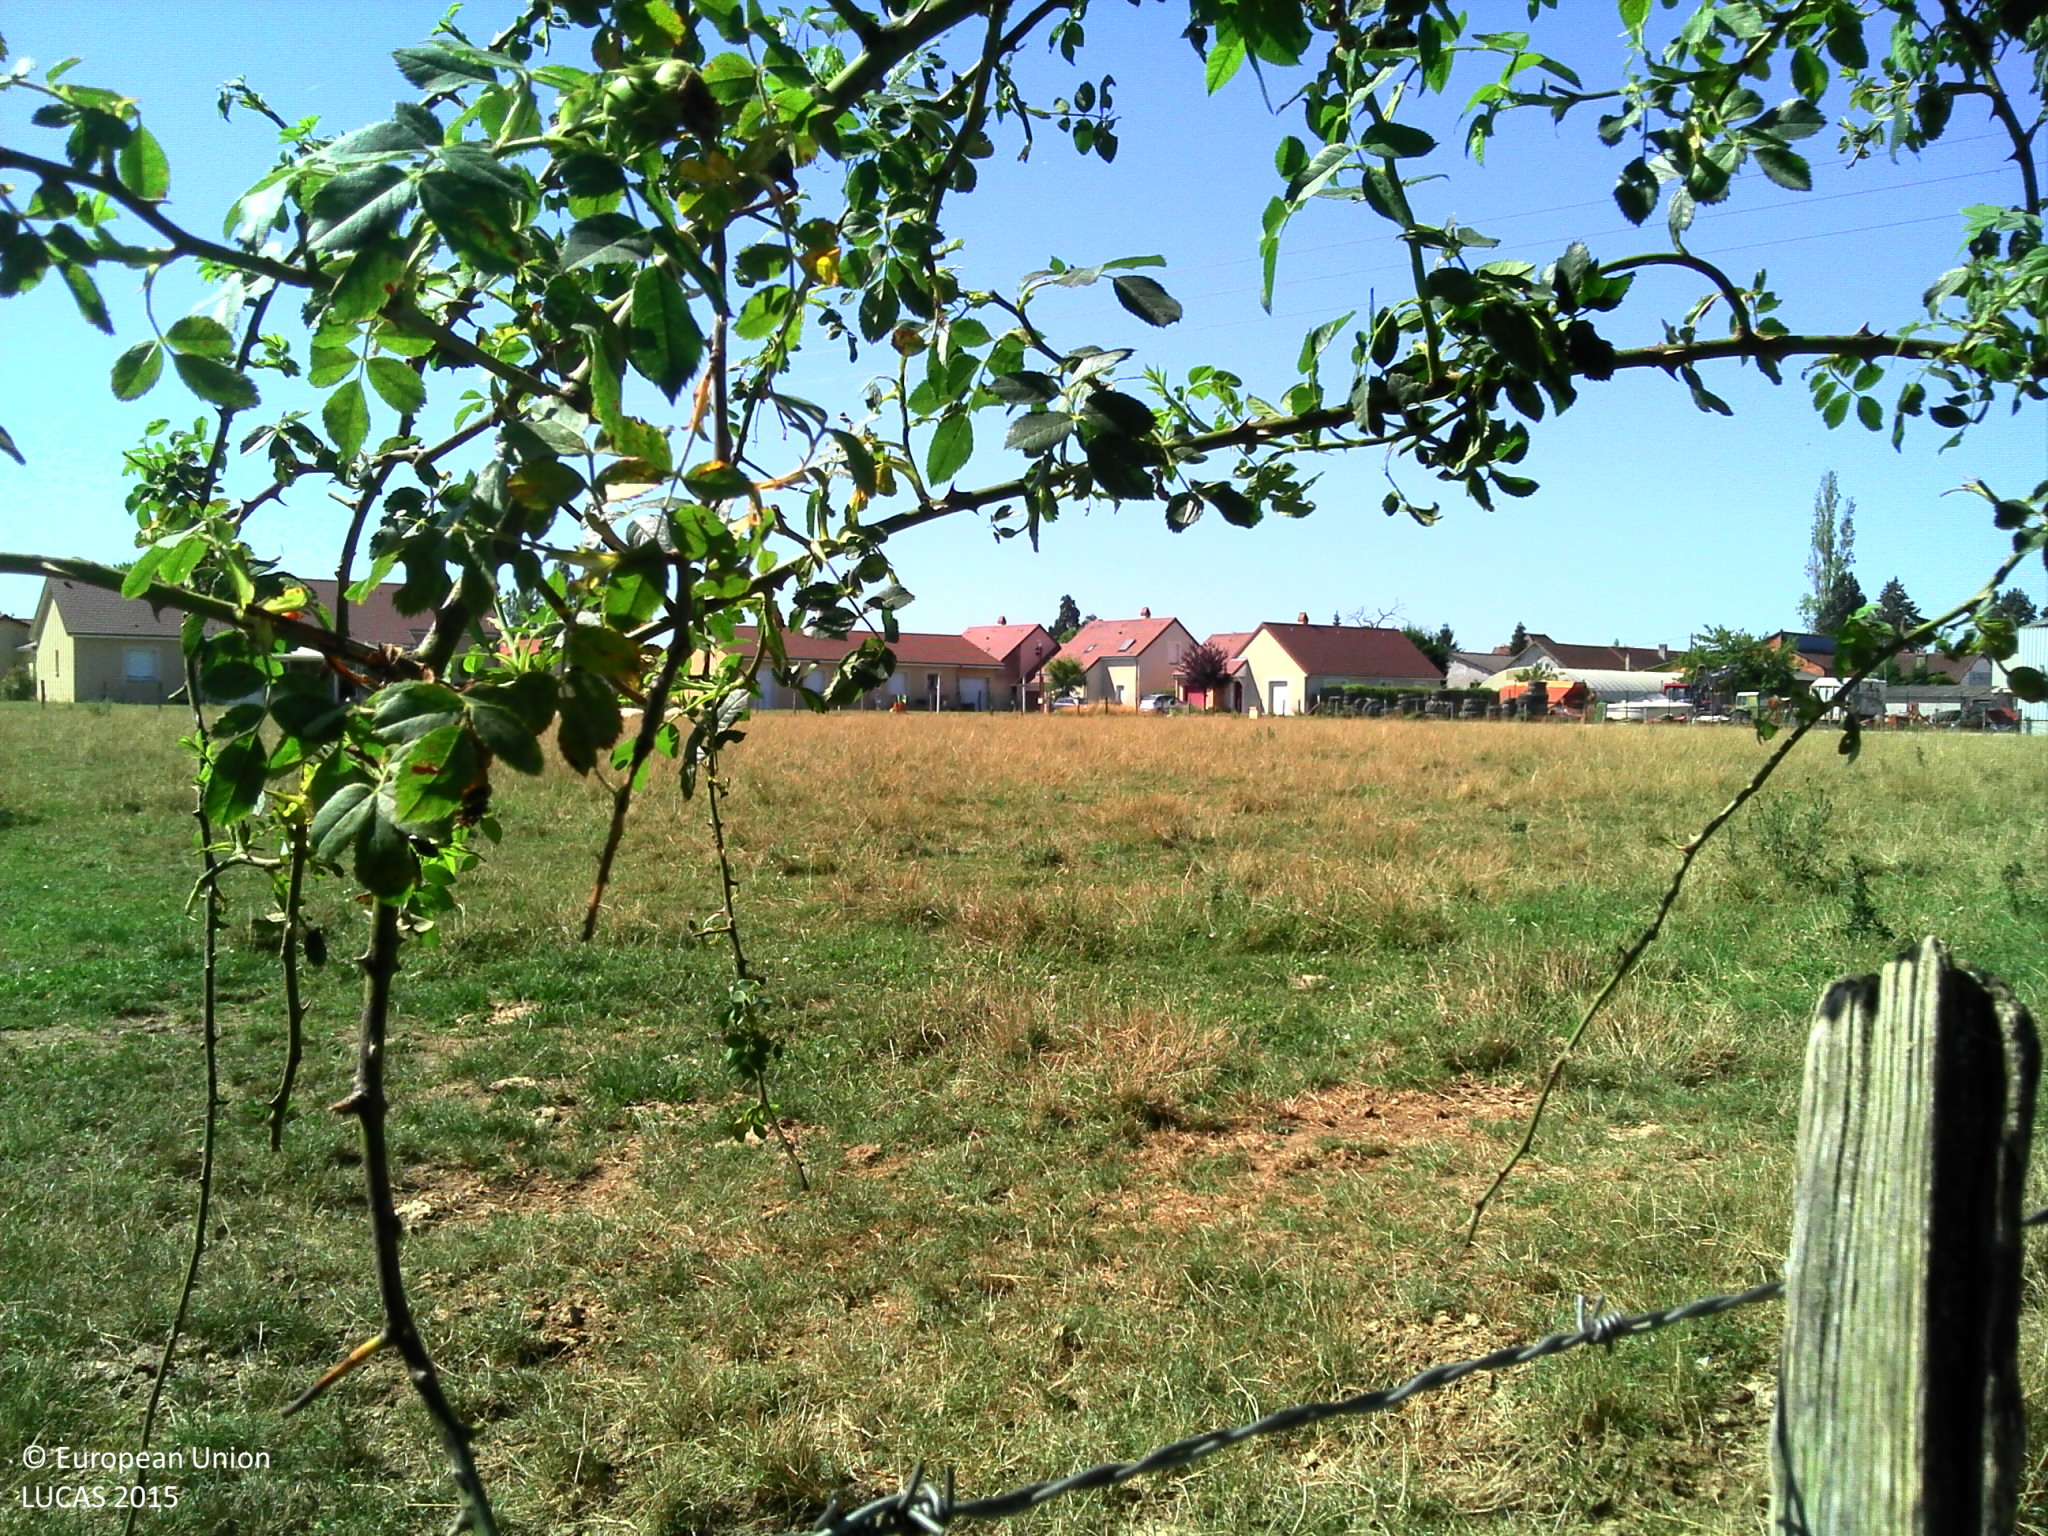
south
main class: Grassland
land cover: Grassland without tree/shrub cover
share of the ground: > 75 %
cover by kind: herbaceous plants 100 %
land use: Agriculture (excluding fallow land and kitchen gardens)
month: June
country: FR
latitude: 46.1936
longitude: 3.2740
